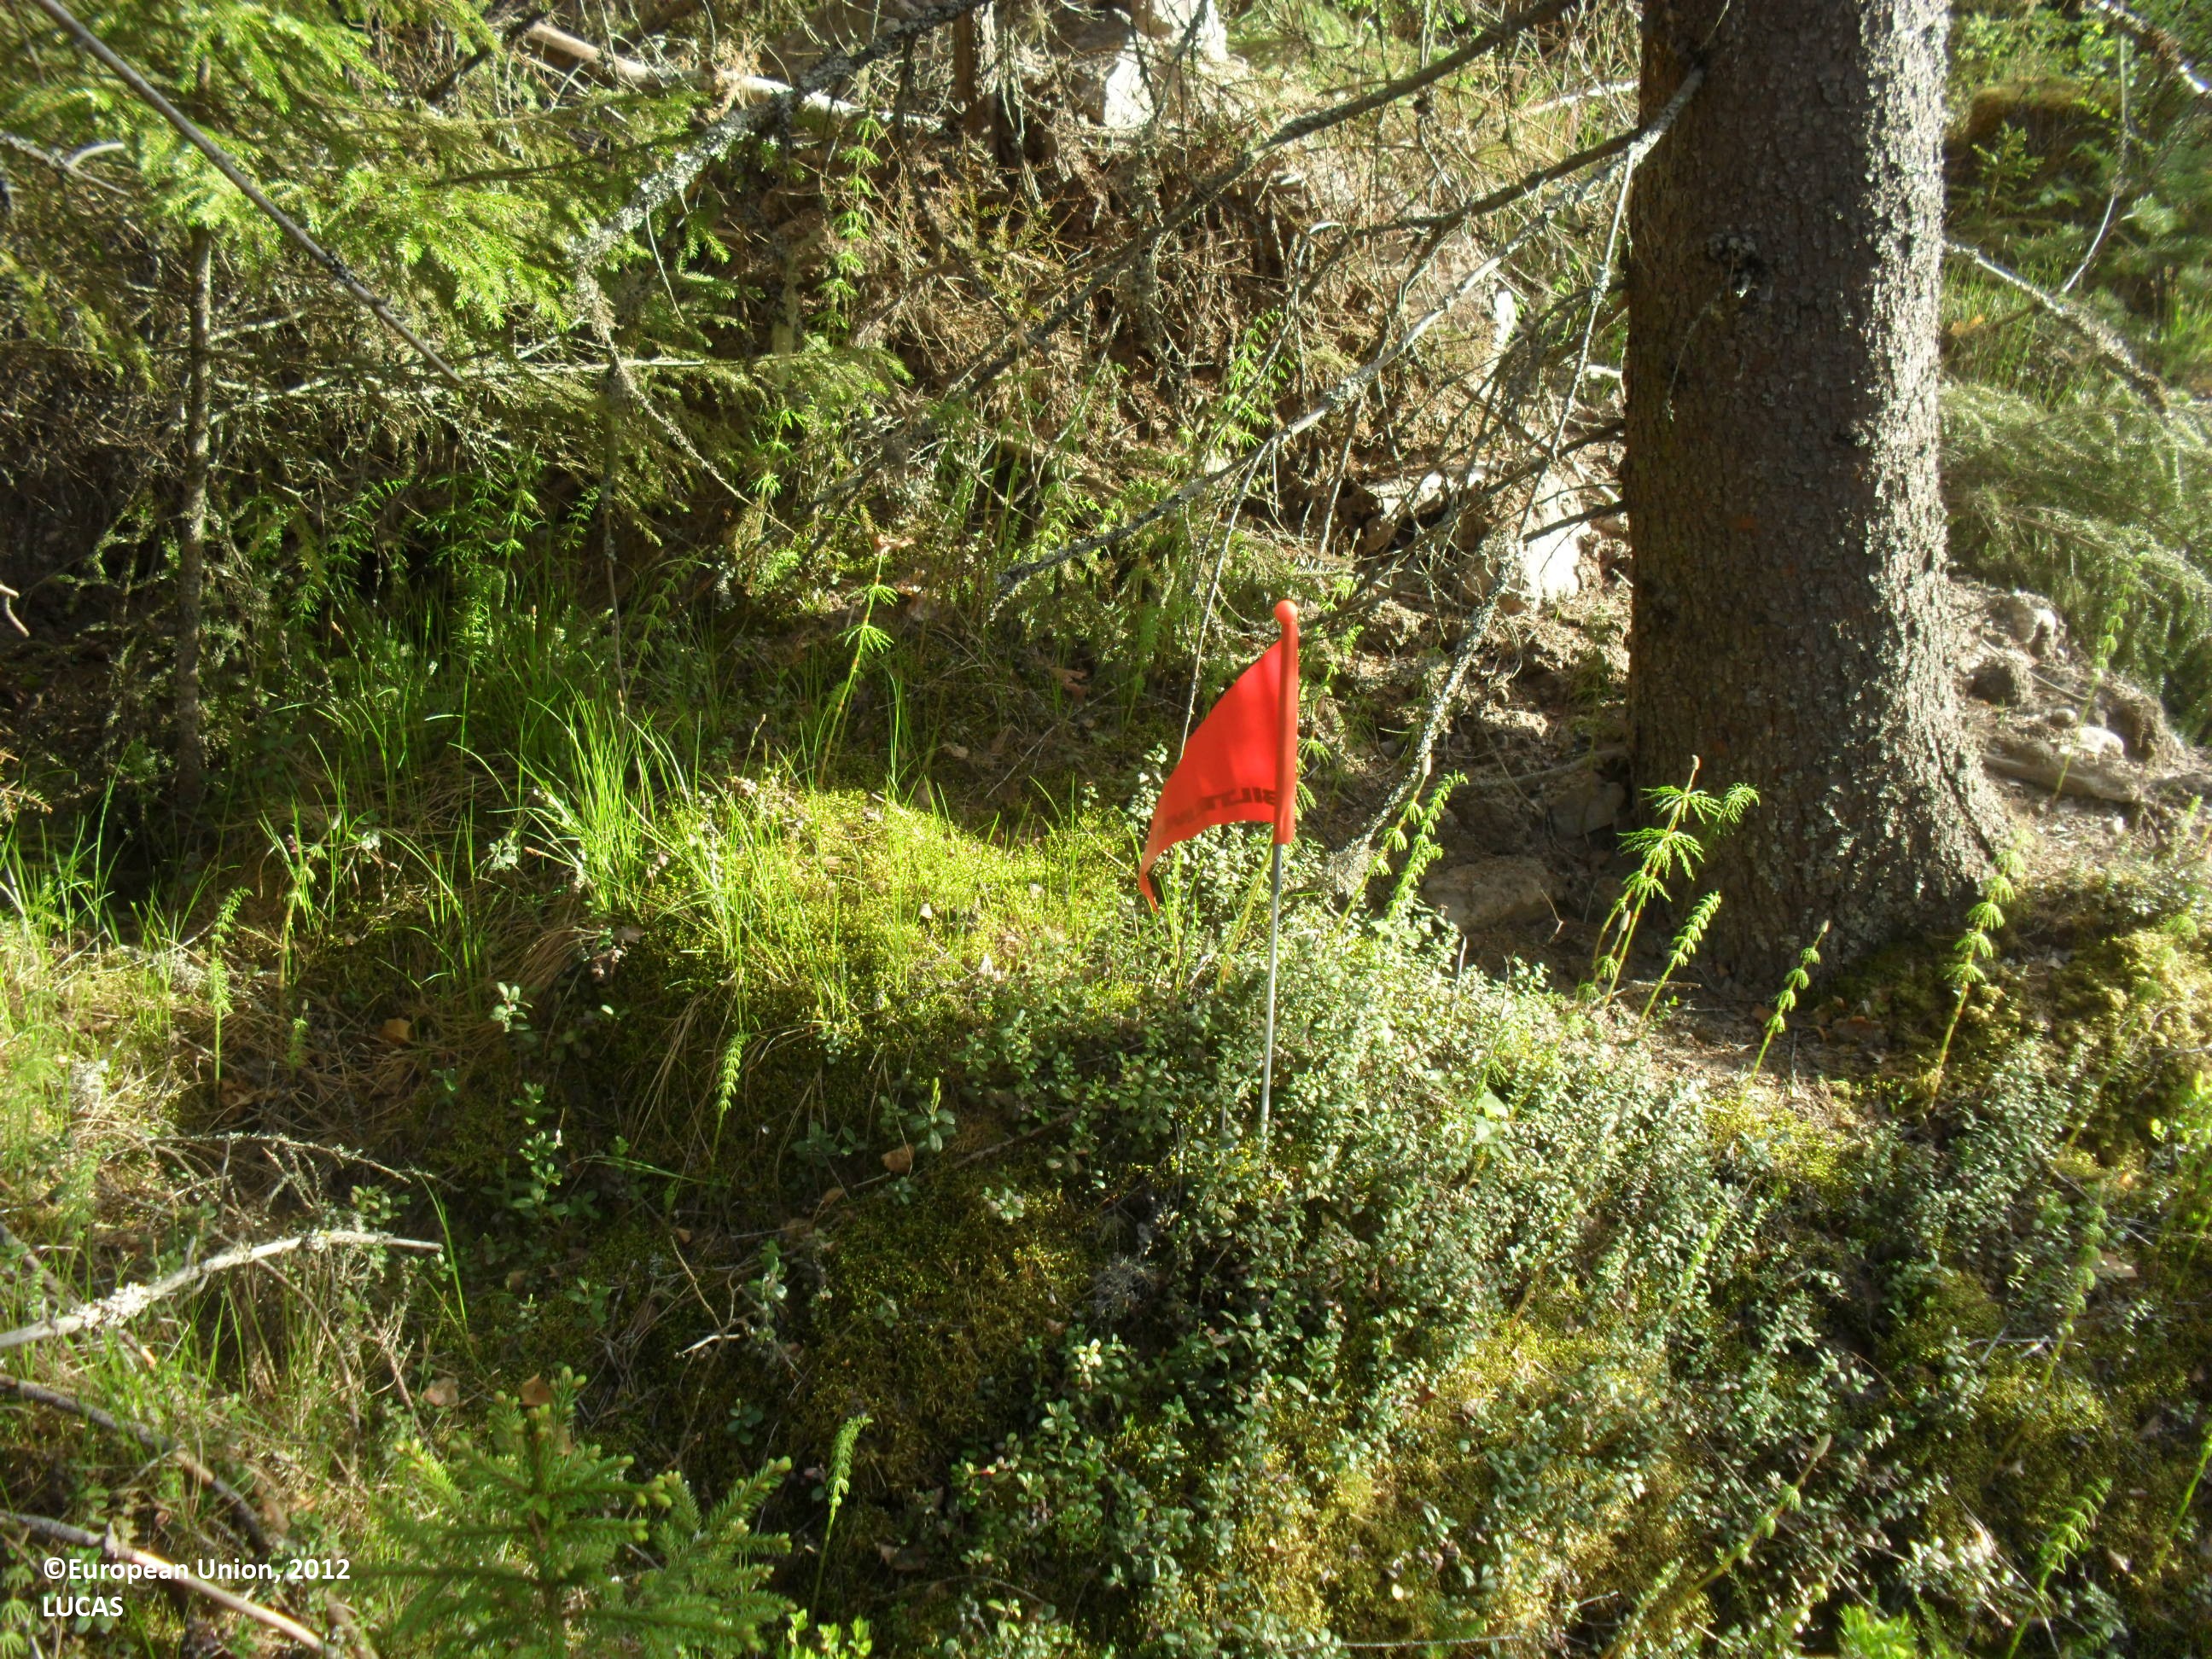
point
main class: Woodland
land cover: Other coniferous woodland
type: boreal forest
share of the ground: 25 - 50 %
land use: Forestry
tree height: > 5 m
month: June
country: FI
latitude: 62.8389
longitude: 23.3591
